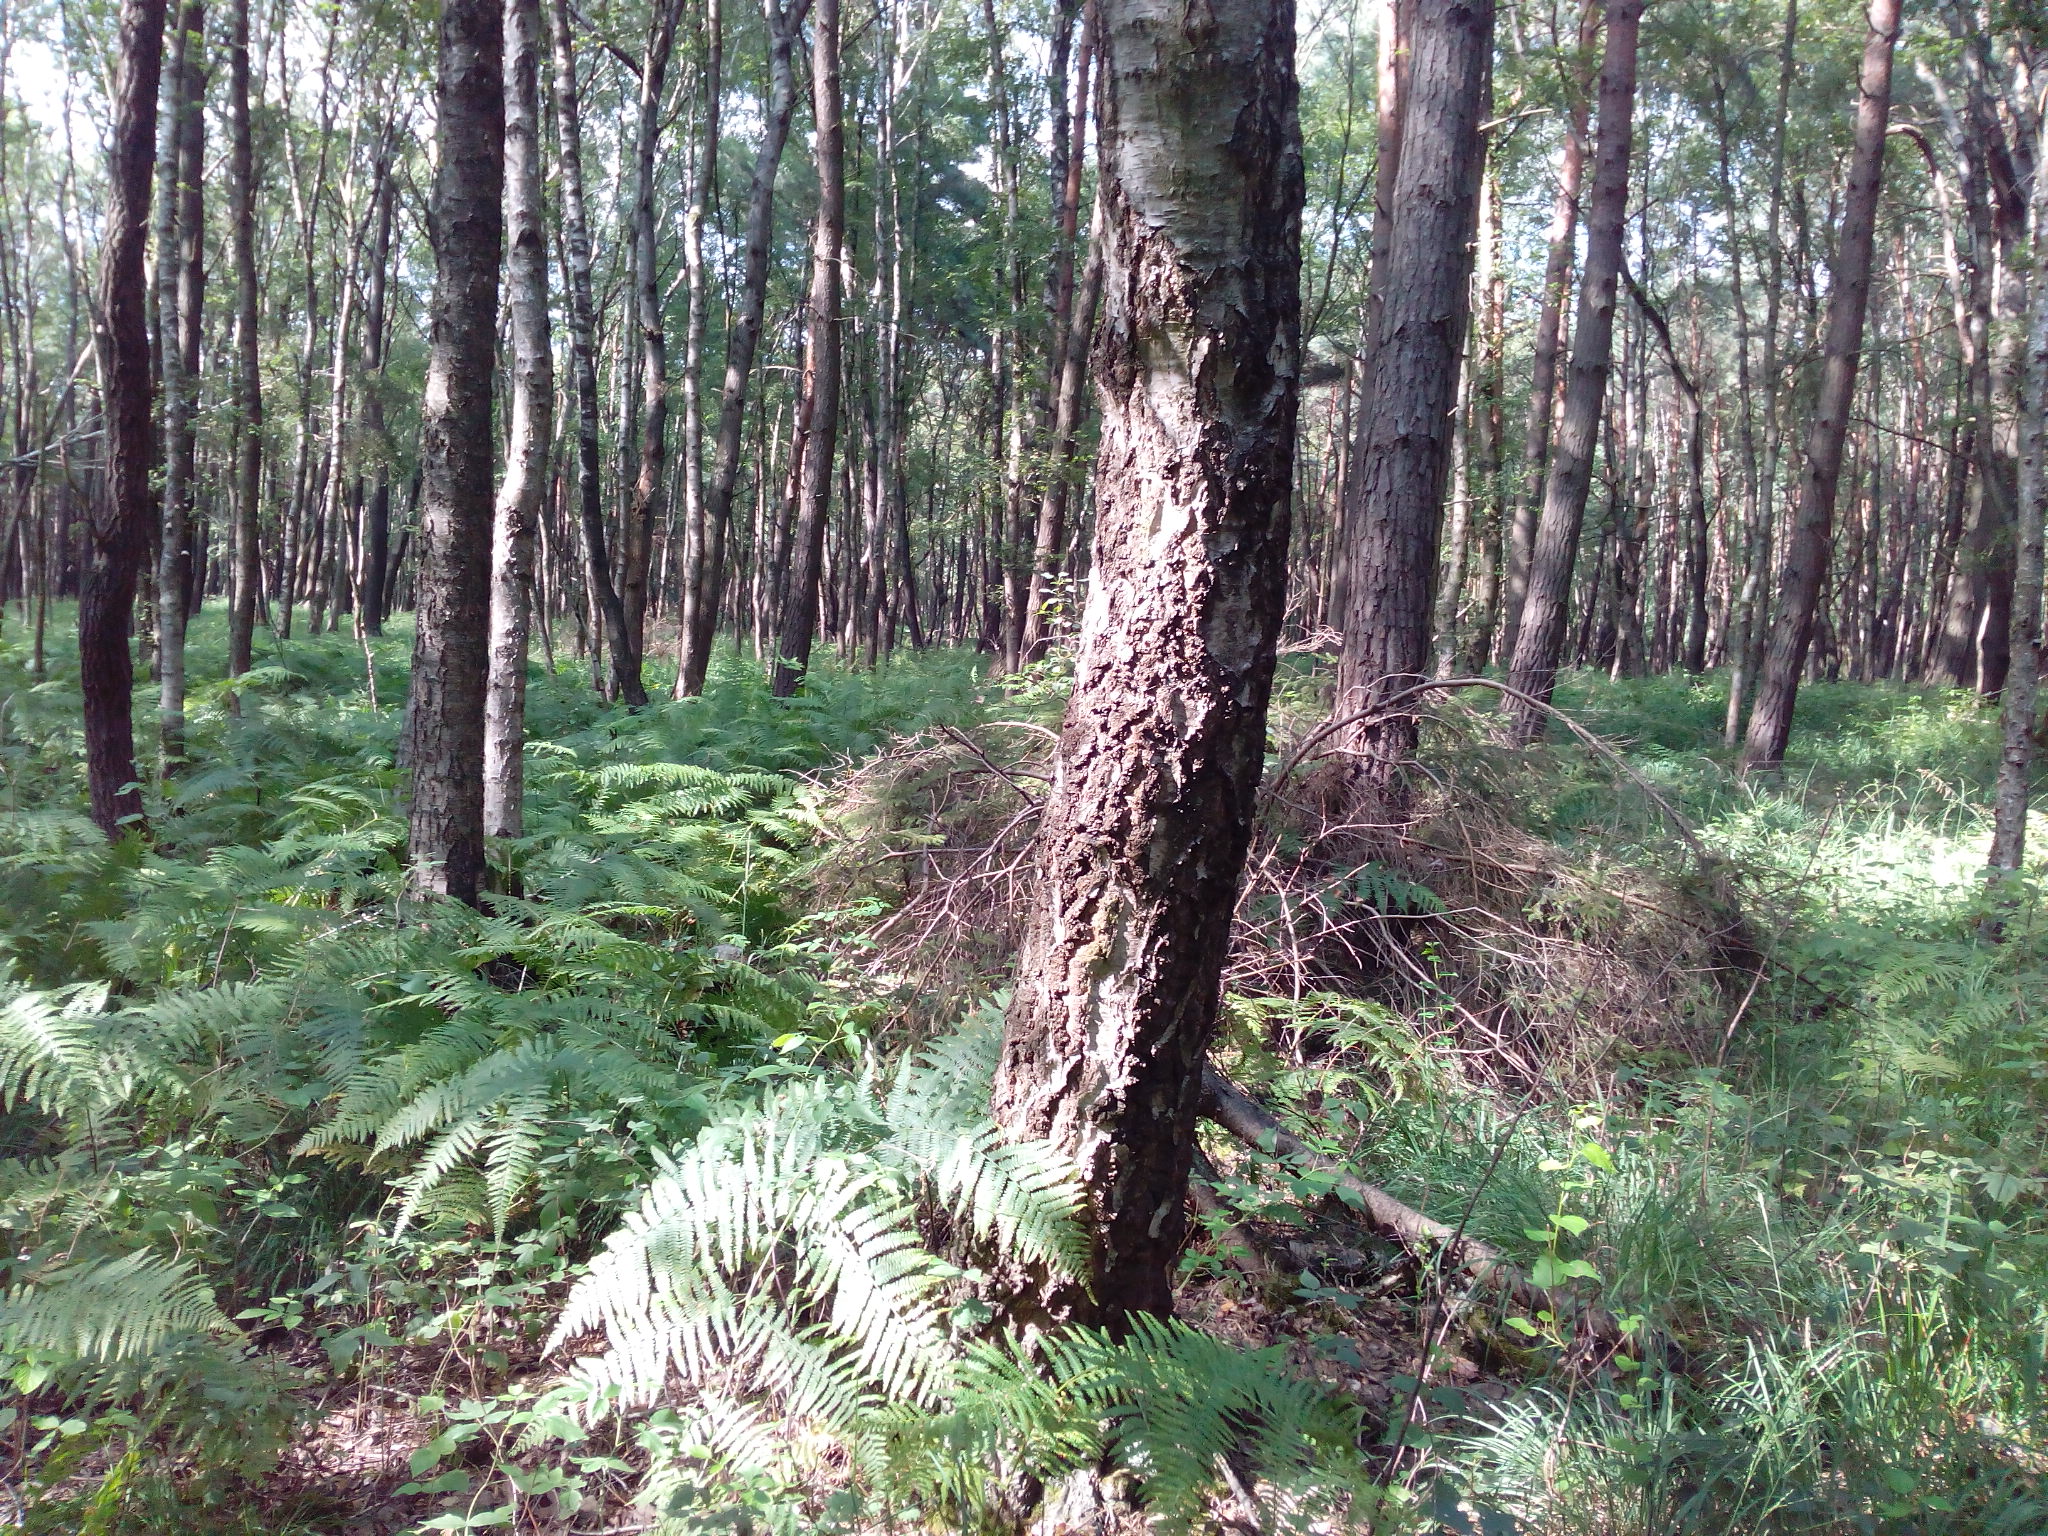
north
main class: Woodland
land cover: Pine dominated mixed woodland
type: hemiboreal forest and nemoral coniferous forest and mixed broadleaved-coniferous forest
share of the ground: > 75 %
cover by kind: broadleaved forest trees 50 %, coniferous forest trees 45 %, herbaceous plants 5 %
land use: Forestry
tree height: > 5 m
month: August
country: DE
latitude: 52.4134
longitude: 9.9265
